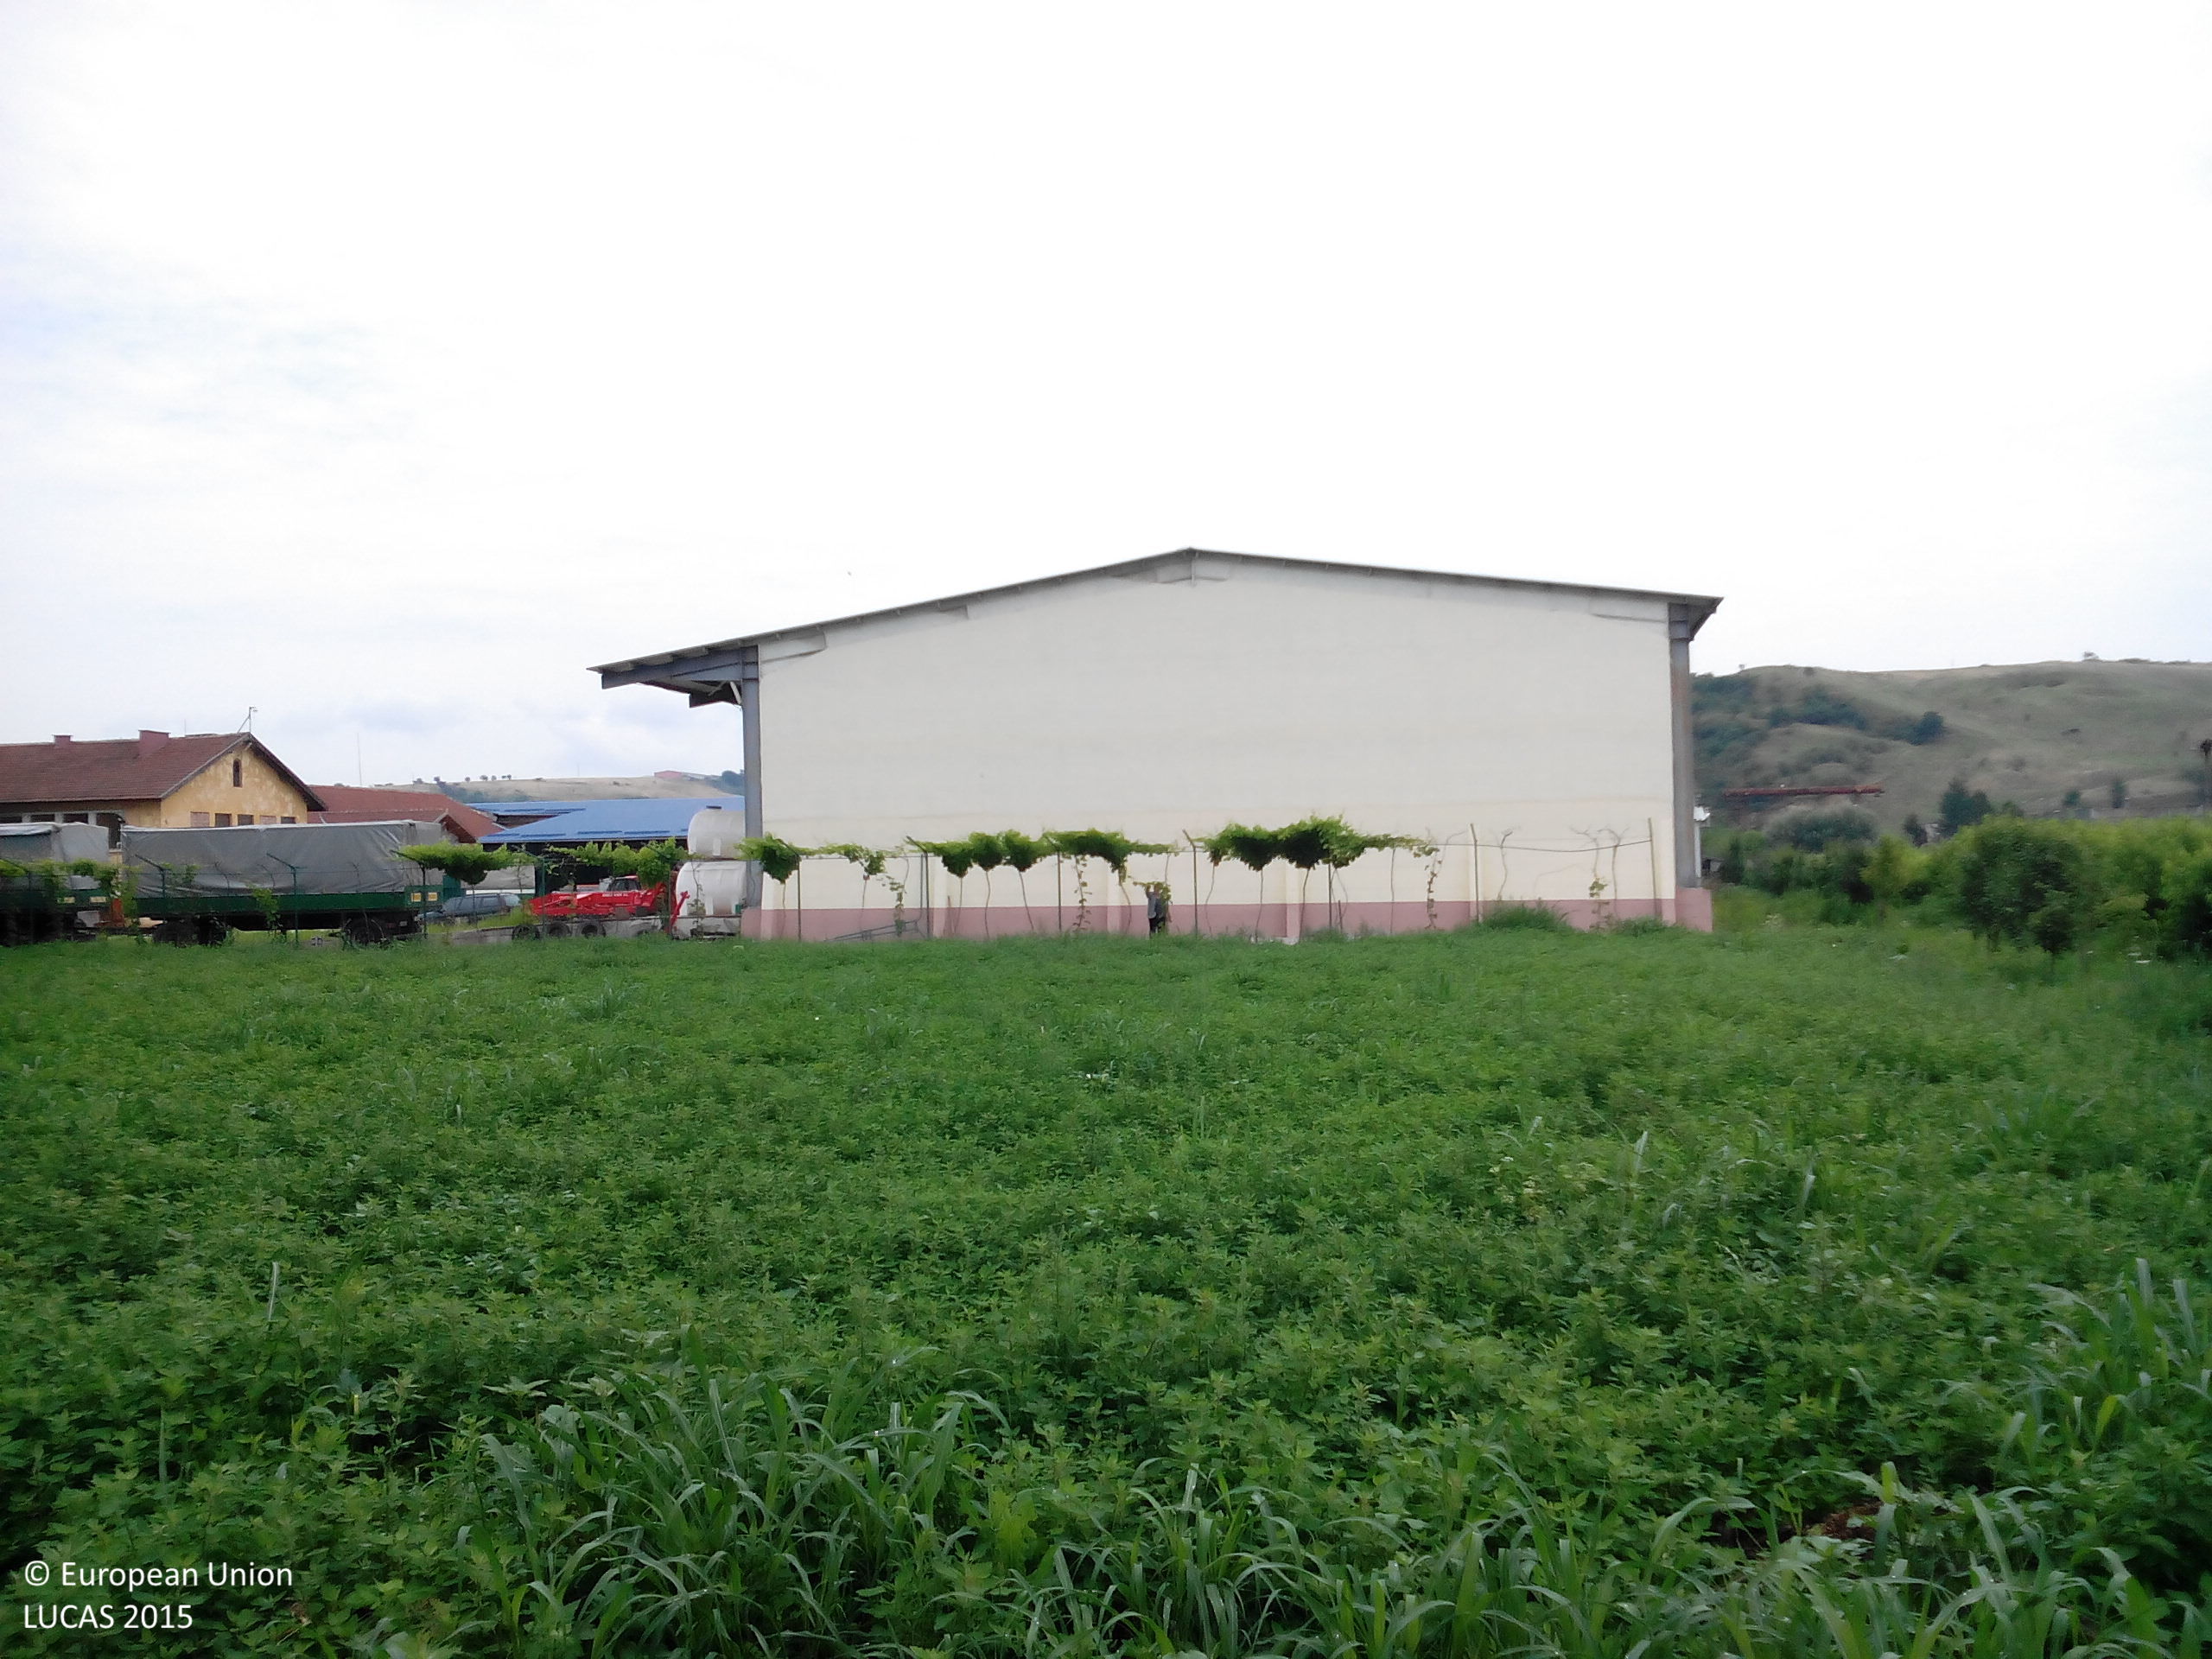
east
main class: Grassland
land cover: Spontaneously vegetated surfaces
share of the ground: > 75 %
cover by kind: herbaceous plants 95 %, shrubs 5 %
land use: Abandoned areas
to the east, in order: Spontaneously vegetated surfaces; Artificial constructions in urban areas
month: July
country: BG
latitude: 43.4519
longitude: 24.2557
